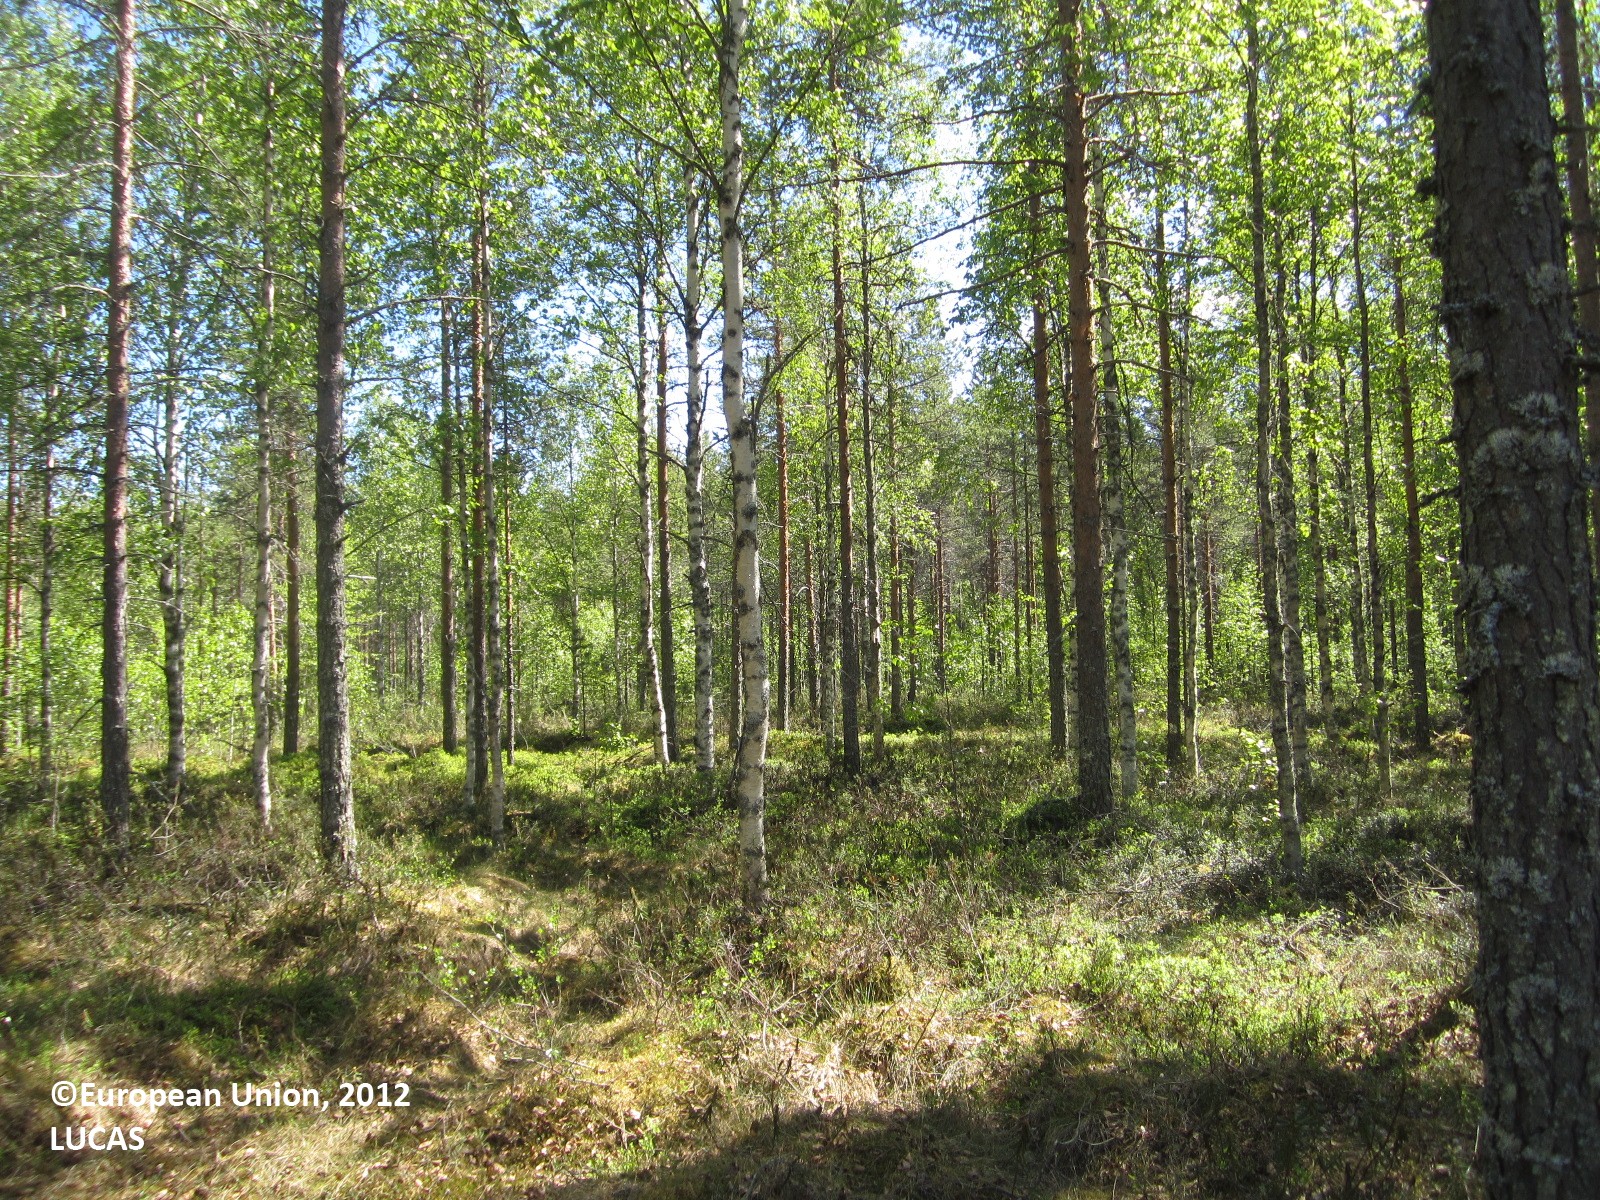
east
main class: Woodland
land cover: Pine dominated mixed woodland
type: boreal forest
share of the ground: 50 - 75 %
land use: Forestry
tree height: > 5 m
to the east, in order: Pine dominated mixed woodland; Ditches and canals; Pine dominated mixed woodland; Ditches and canals; Pine dominated mixed woodland; Ditches and canals; Pine dominated mixed woodland; Ditches and canals; Pine dominated mixed woodland; Pine dominated coniferous woodland; Pine dominated mixed woodland; Ditches and canals; Pine dominated mixed woodland; Spruce dominated coniferous woodland; Ditches and canals; Spruce dominated coniferous woodland; Pine dominated mixed woodland
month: June
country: FI
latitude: 64.9034
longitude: 28.7967
